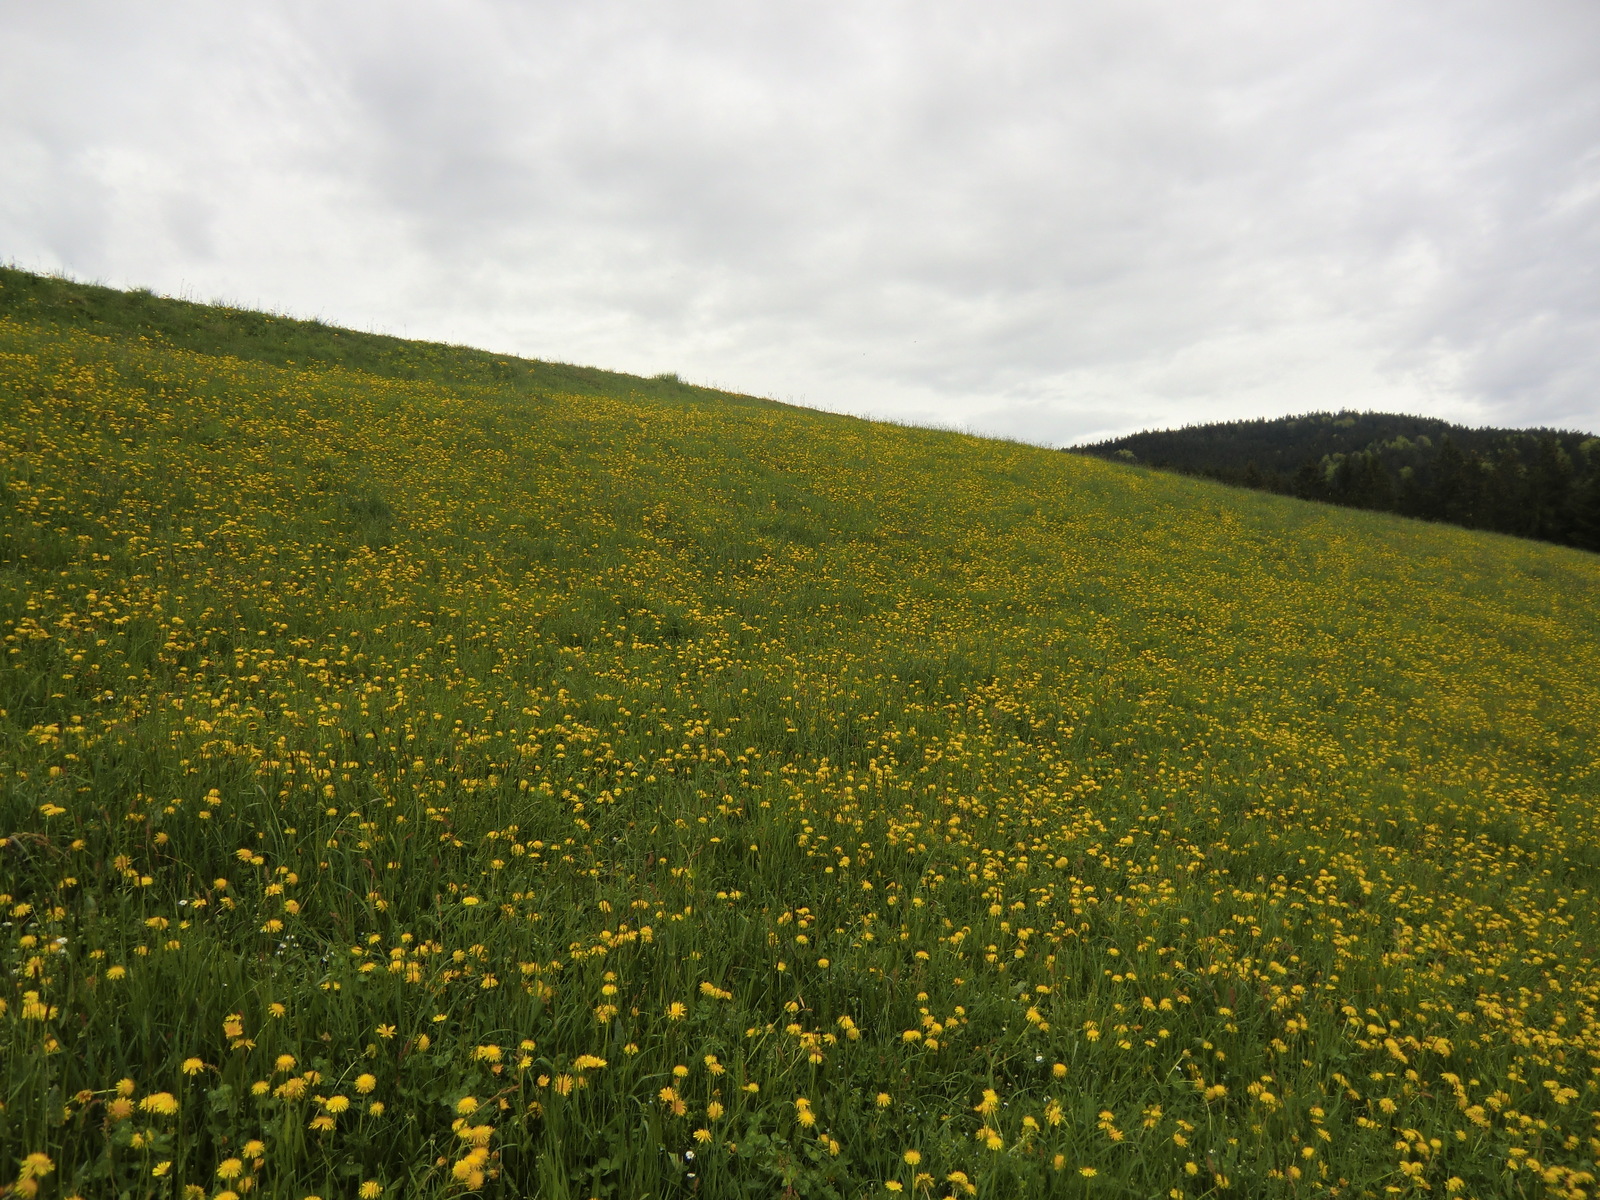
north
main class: Grassland
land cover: Grassland without tree/shrub cover
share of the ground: > 75 %
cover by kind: herbaceous plants 100 %
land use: Agriculture (excluding fallow land and kitchen gardens)
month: May
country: AT
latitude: 48.3526
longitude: 14.8186
